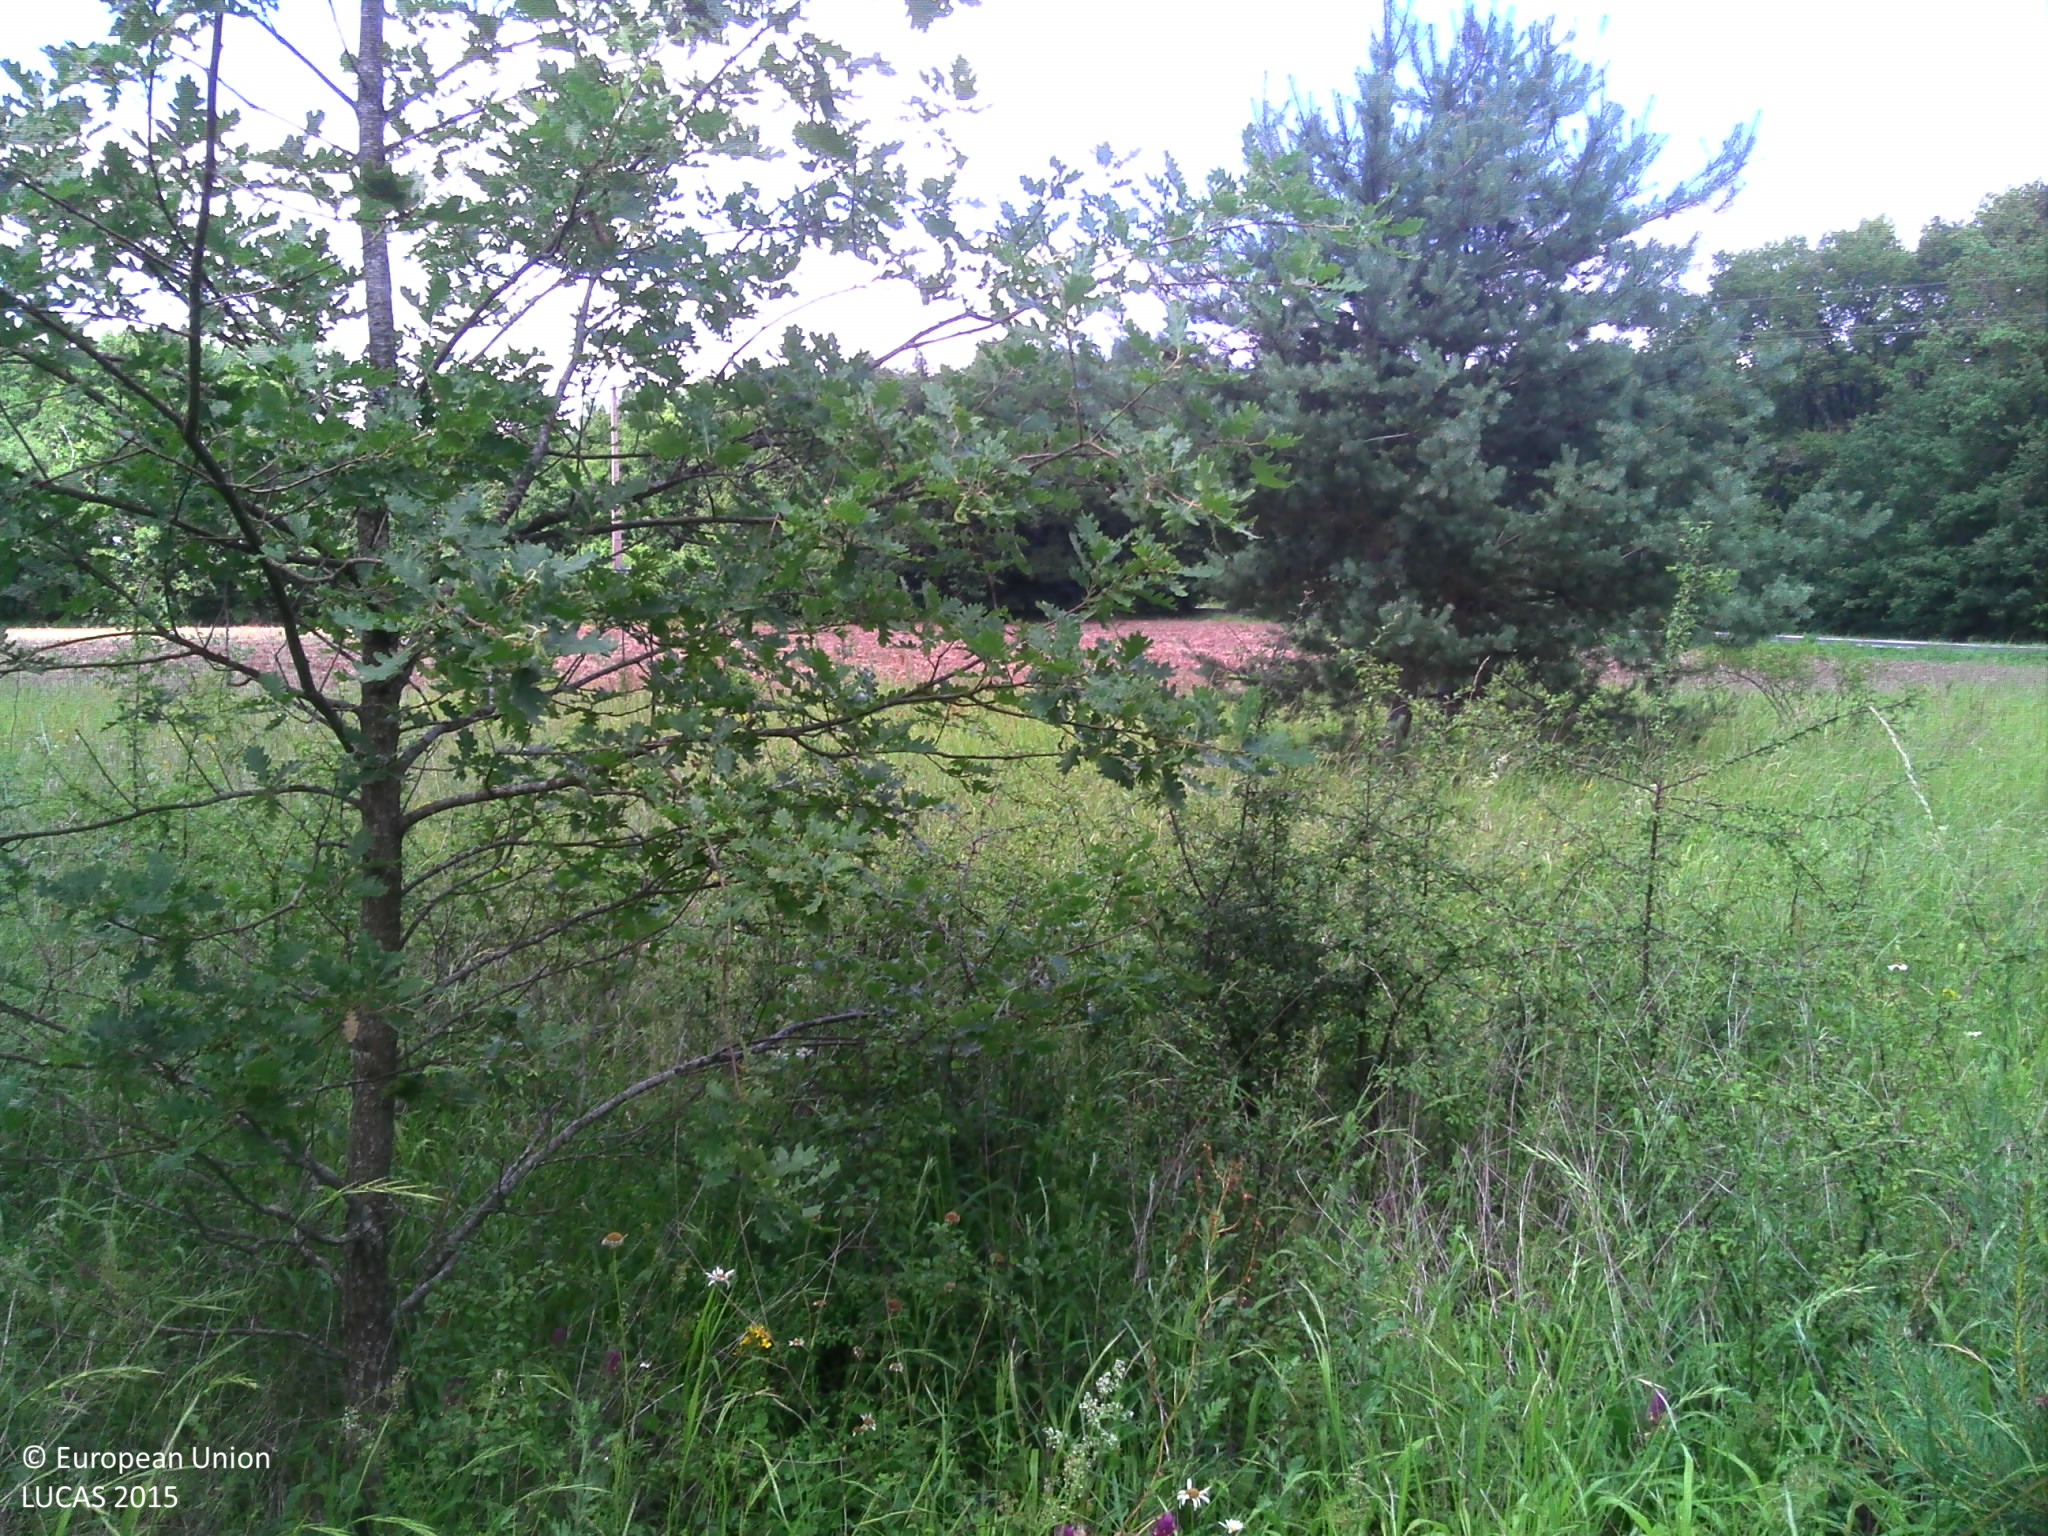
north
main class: Woodland
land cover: Broadleaved woodland
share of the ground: > 75 %
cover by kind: broadleaved forest trees 50 %, shrubs 35 %, herbaceous plants 10 %, coniferous forest trees 5 %
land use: Forestry
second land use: Residential
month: June
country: FR
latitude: 47.3141
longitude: 0.8143
